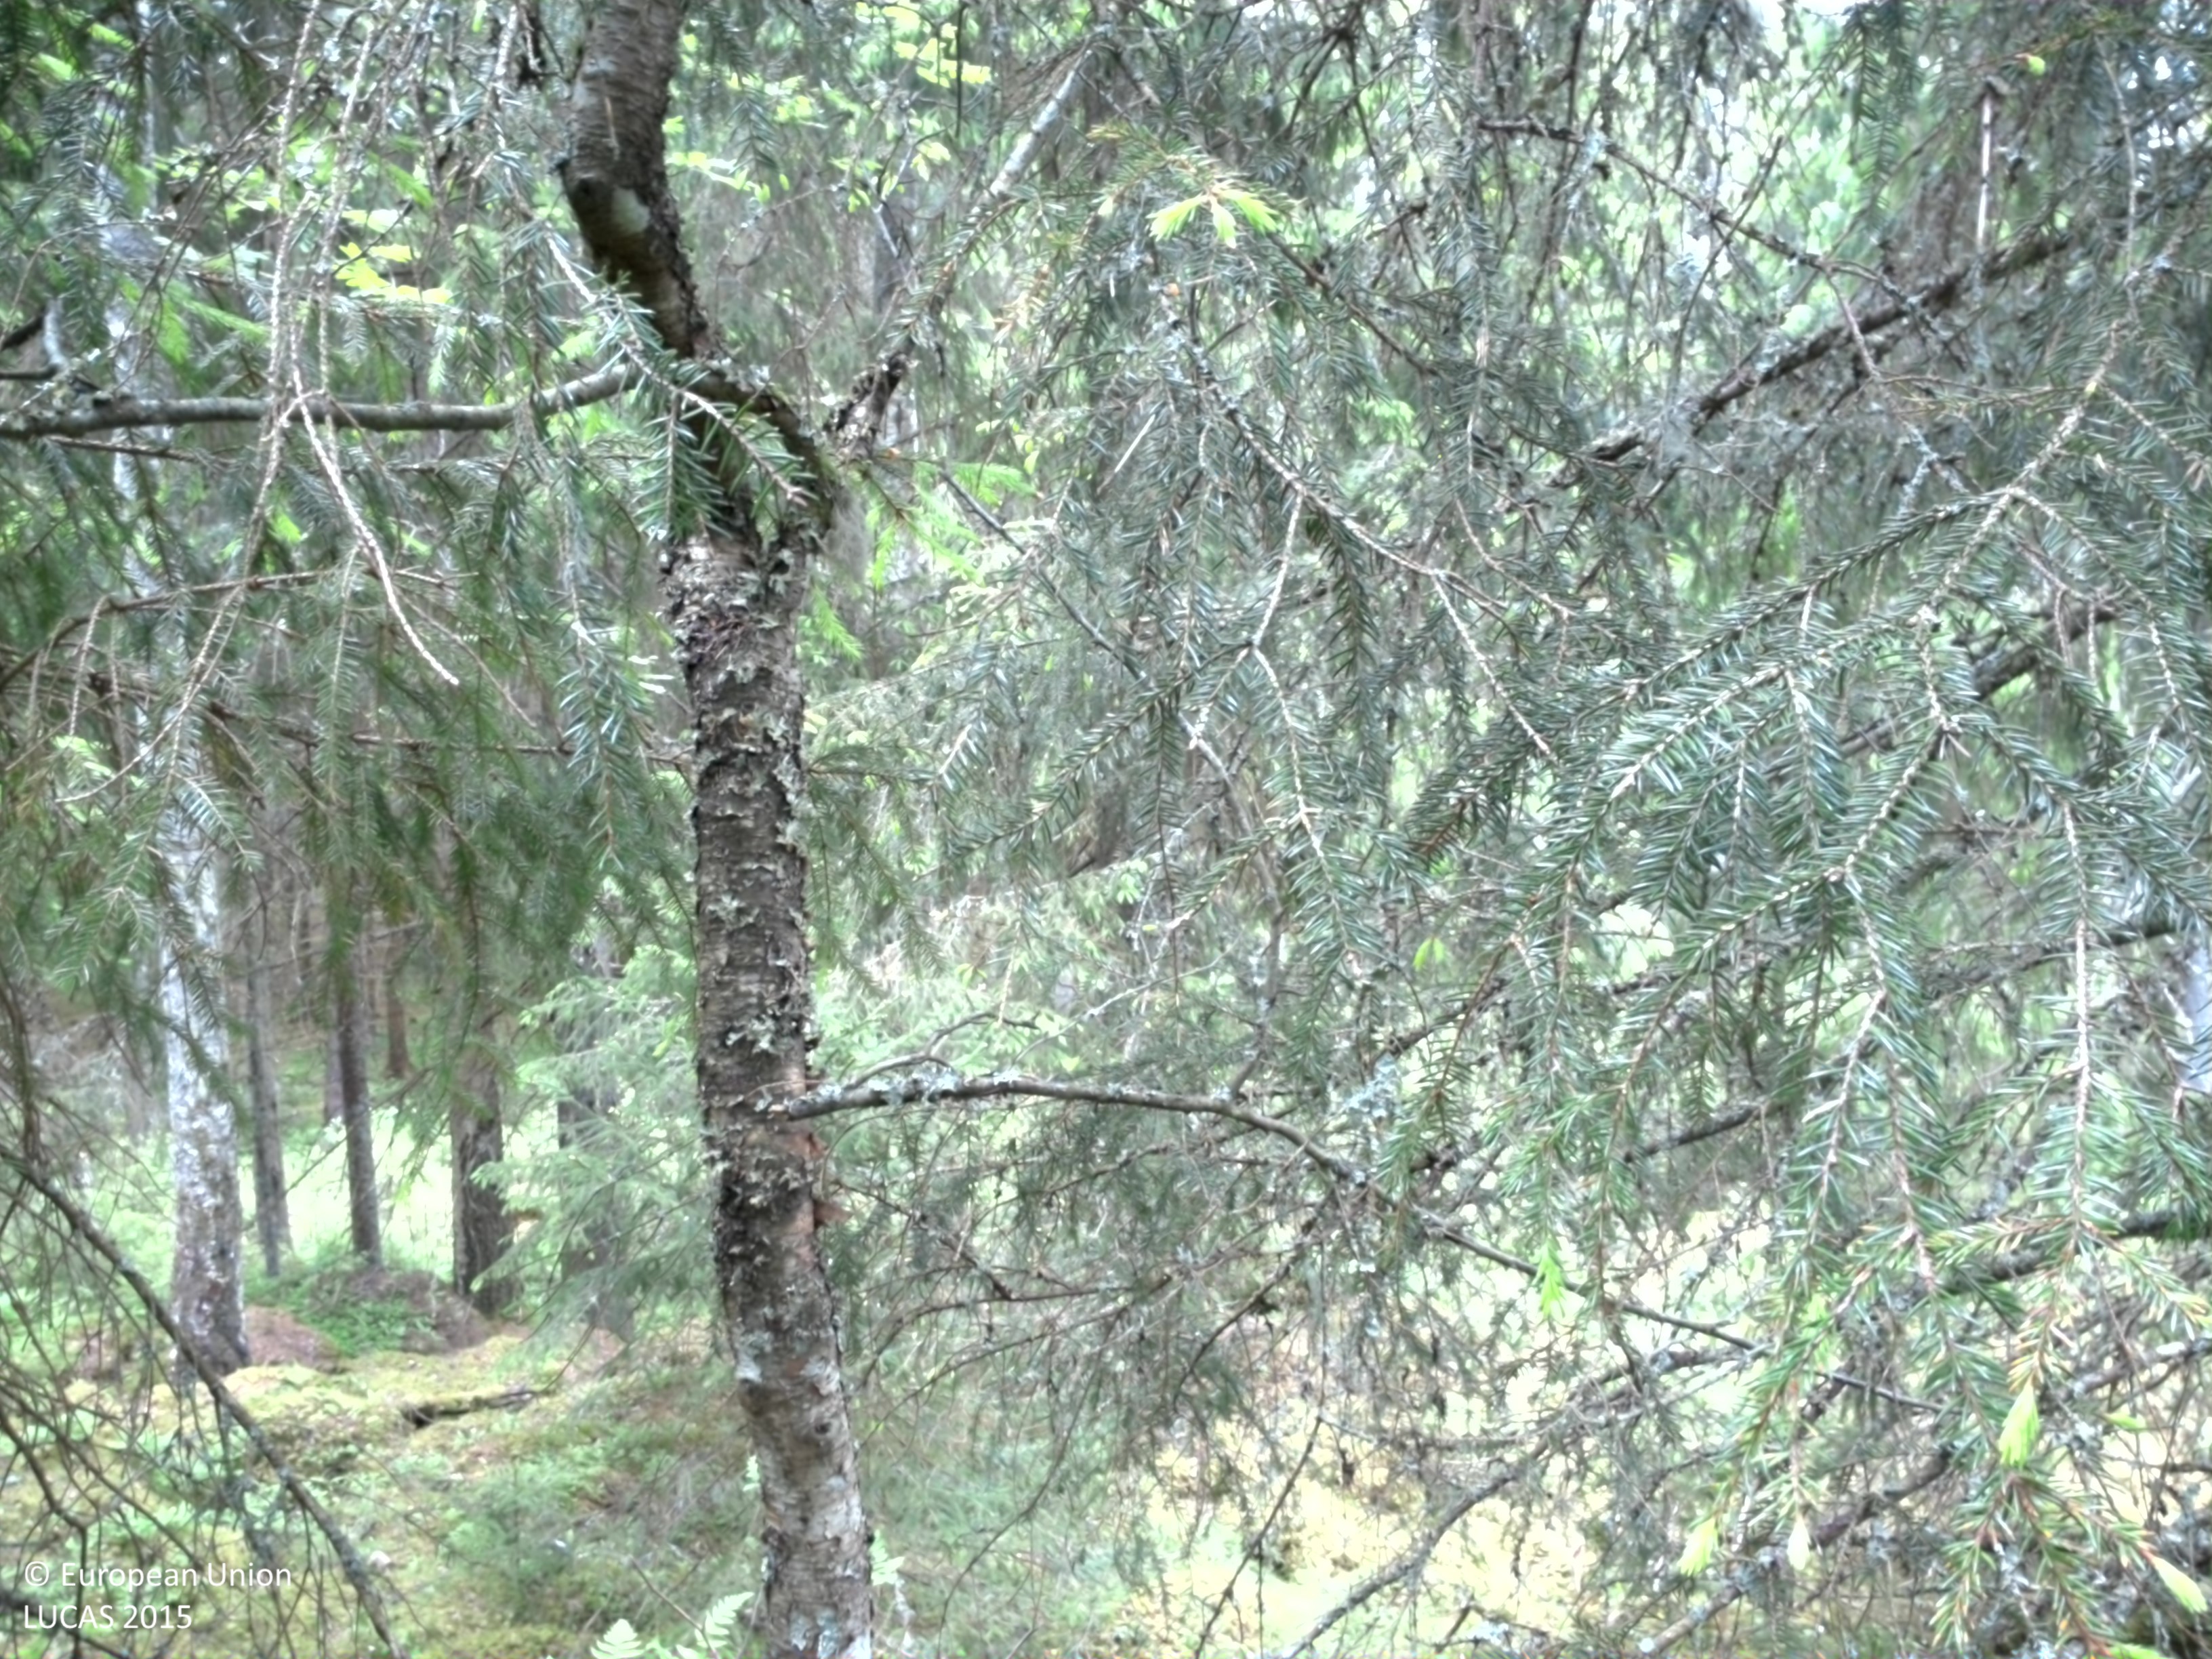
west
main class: Woodland
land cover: Spruce dominated mixed woodland
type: boreal forest
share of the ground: > 75 %
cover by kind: coniferous forest trees 55 %, broadleaved forest trees 25 %, shrubs 10 %, lichens and mosses 10 %
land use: Forestry
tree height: > 5 m
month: June
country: SE
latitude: 59.6137
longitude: 14.1914
